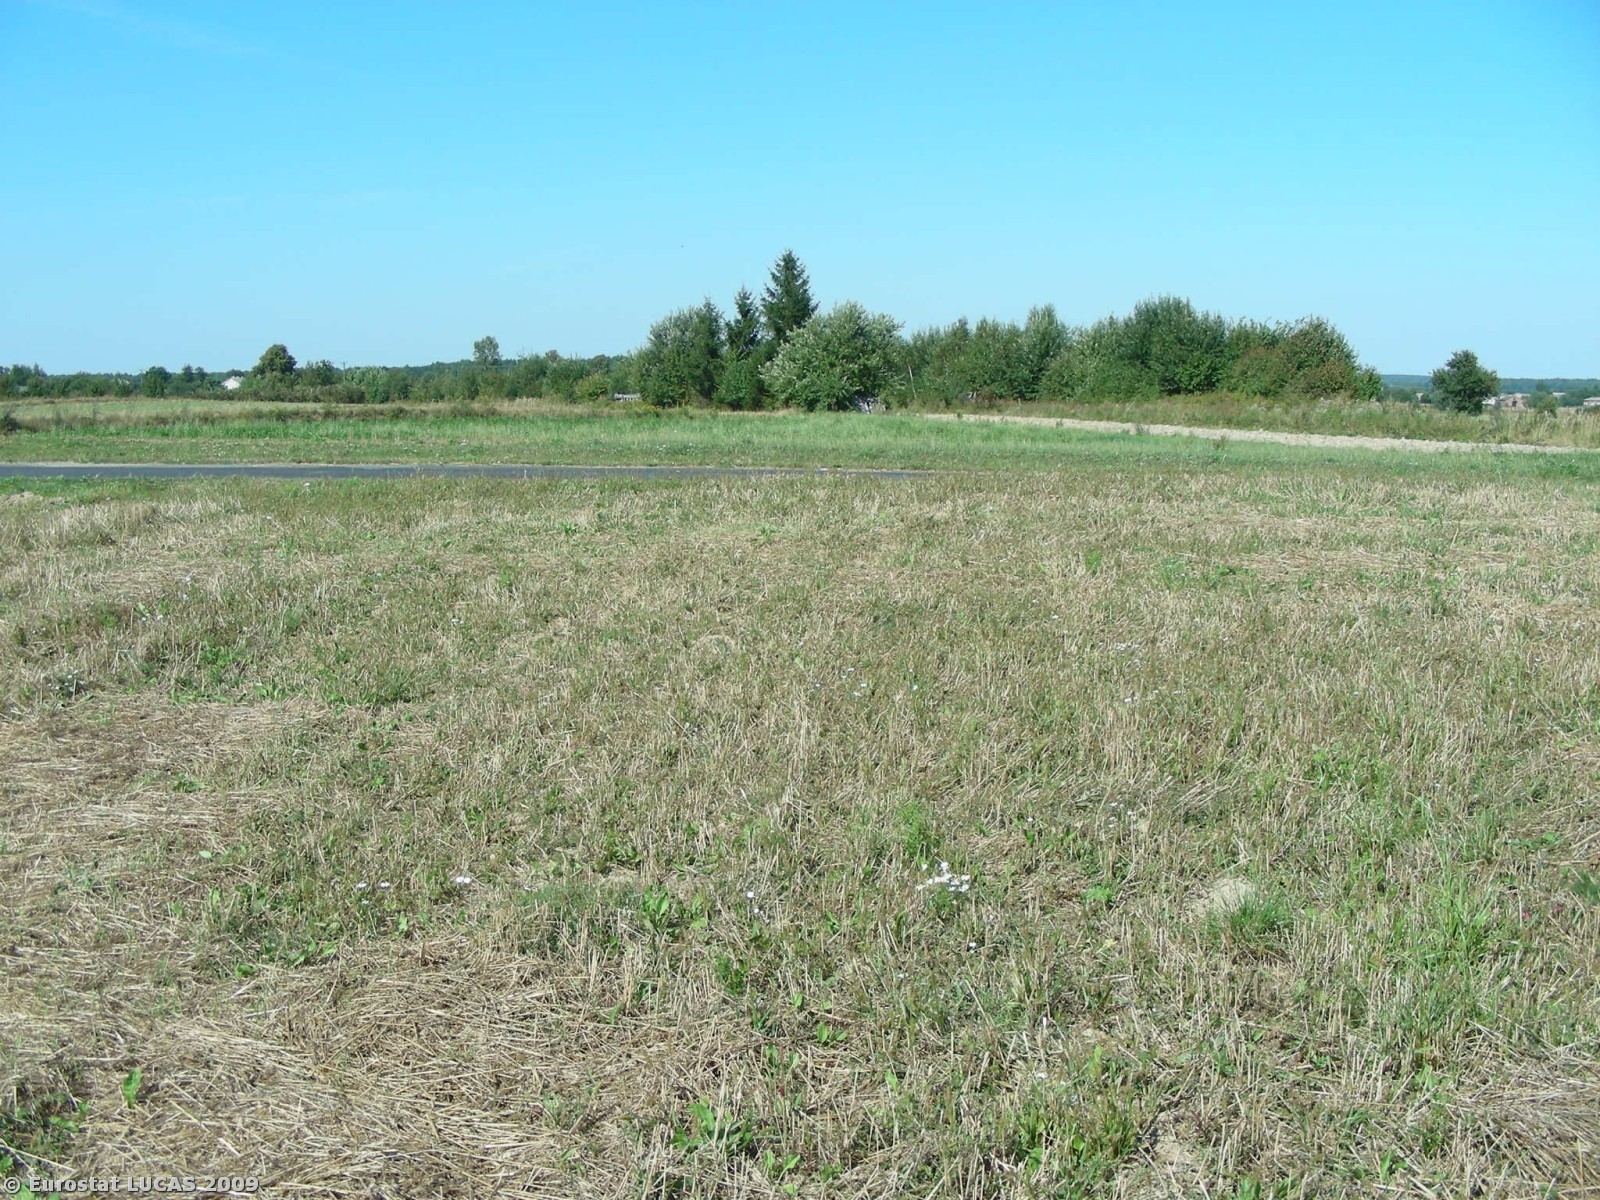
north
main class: Cropland
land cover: Common wheat
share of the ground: < 10 %
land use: Agriculture (excluding fallow land and kitchen gardens)
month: September
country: PL
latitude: 50.8944
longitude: 22.3331
